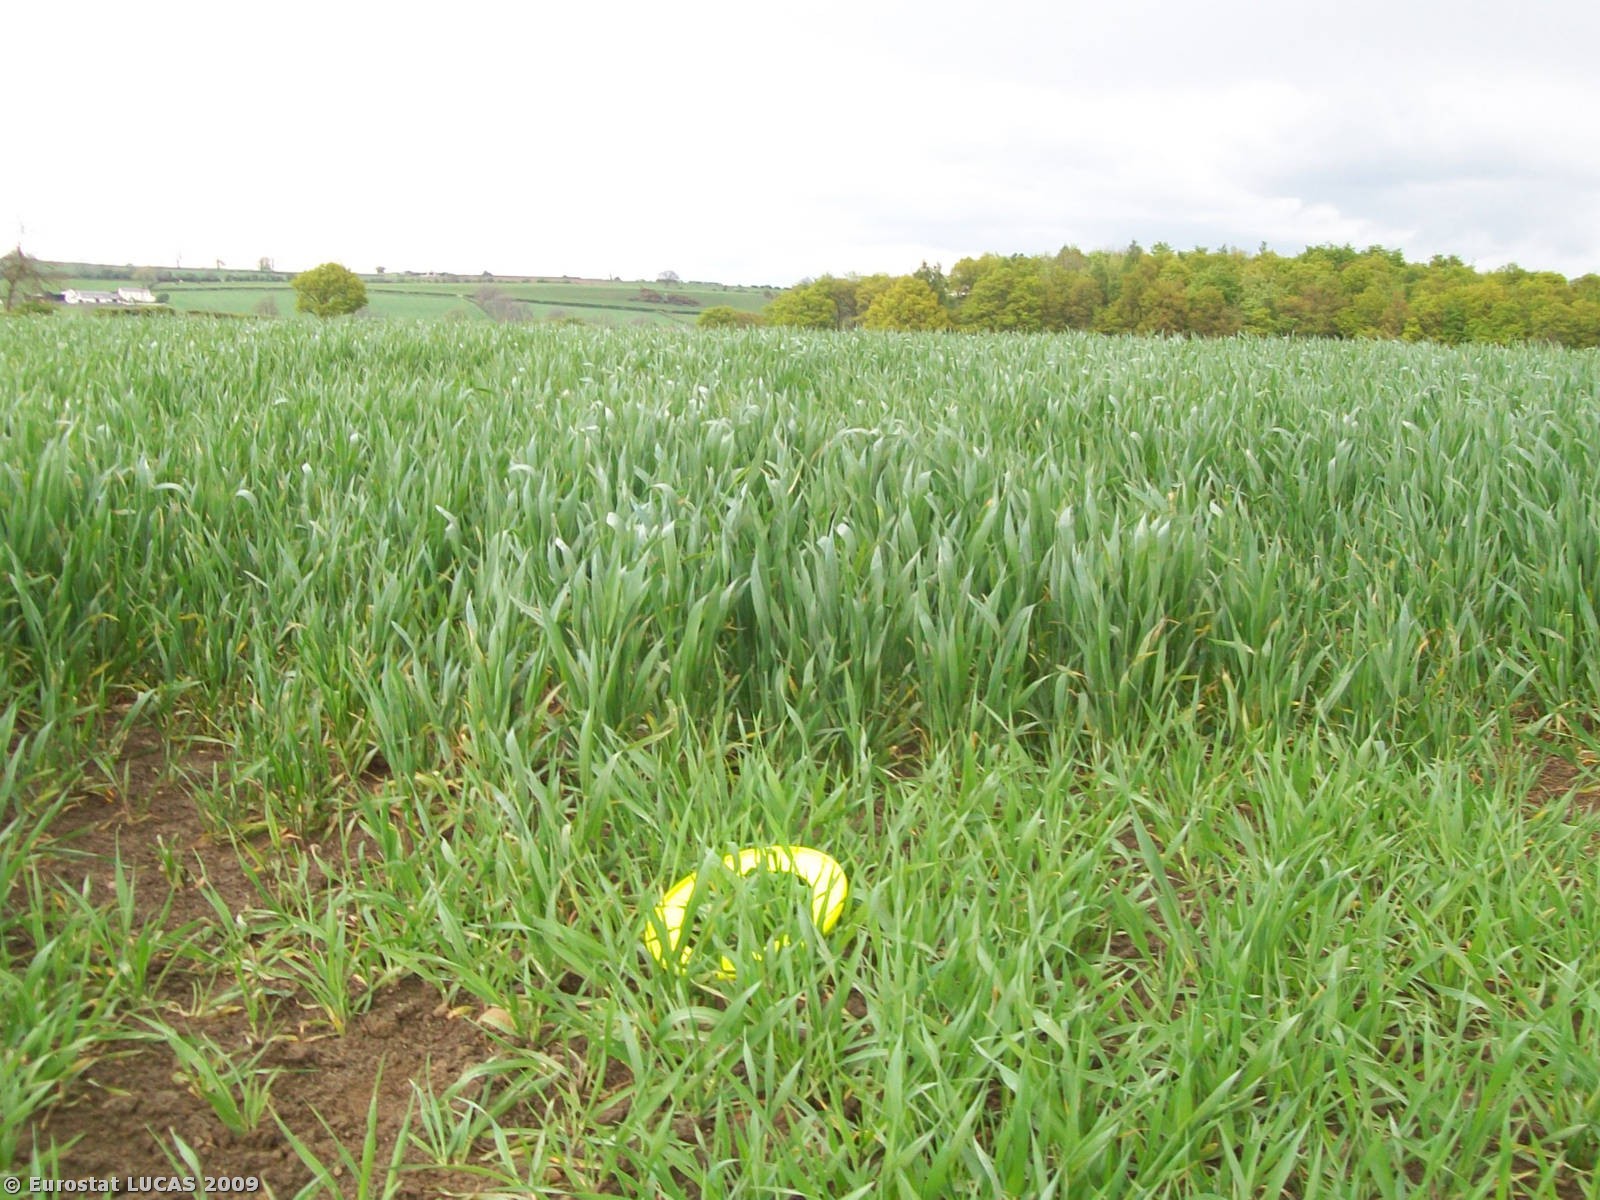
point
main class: Cropland
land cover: Barley
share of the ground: < 10 %
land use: Agriculture (excluding fallow land and kitchen gardens)
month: May
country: GB
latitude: 54.5804
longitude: -1.6700
